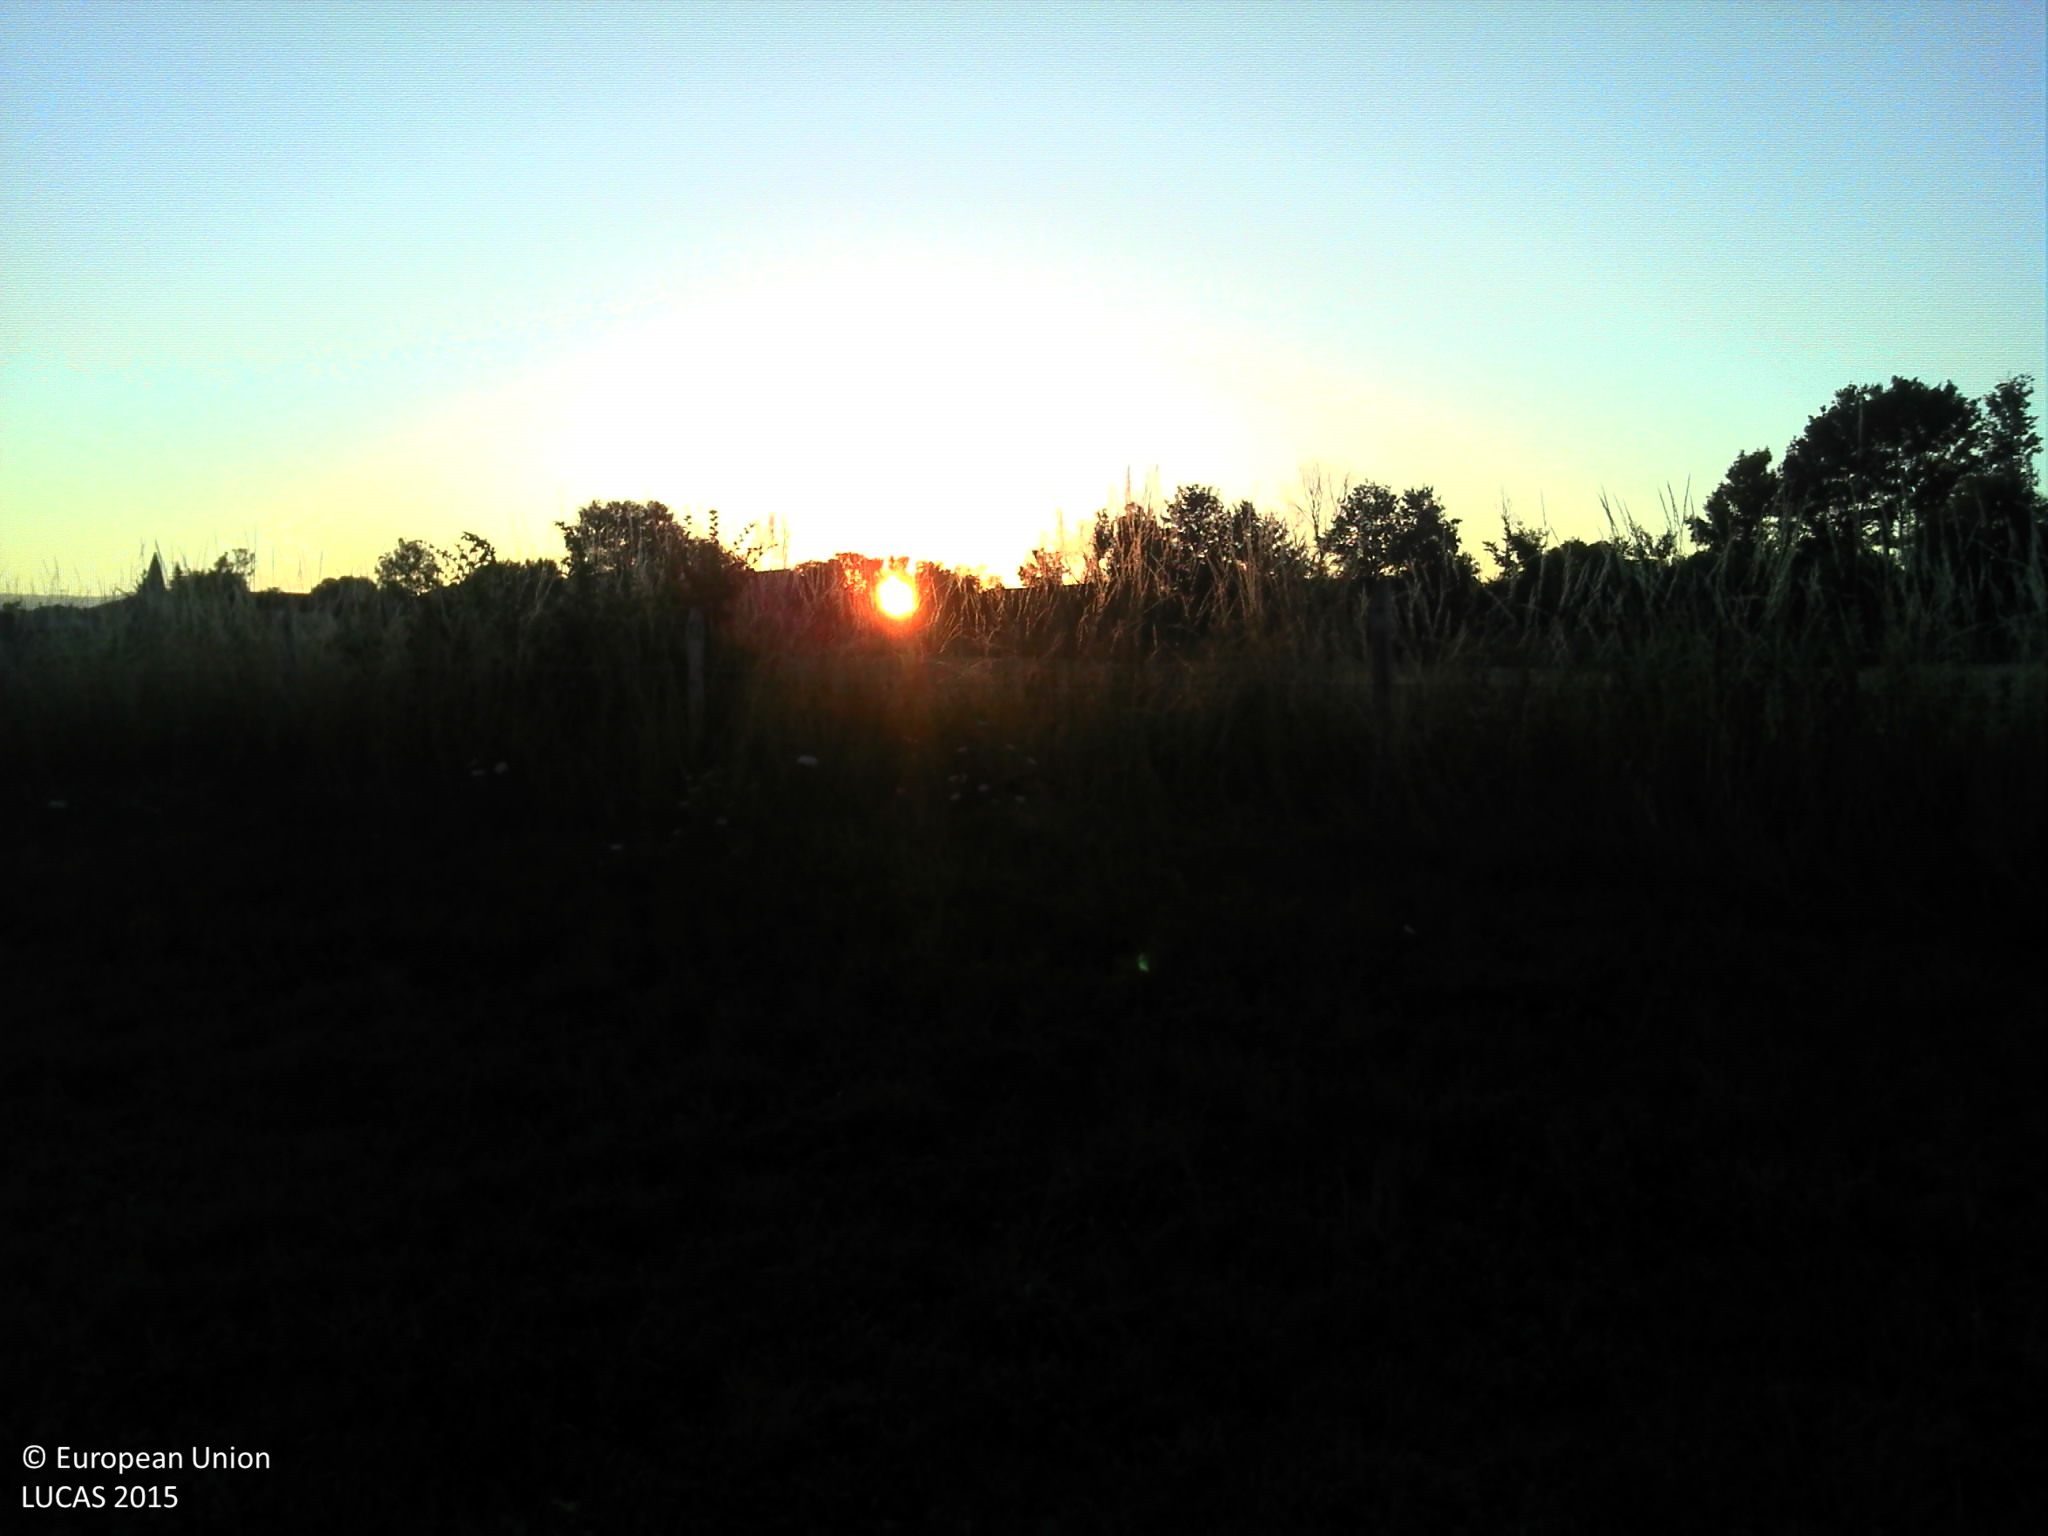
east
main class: Grassland
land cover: Grassland without tree/shrub cover
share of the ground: > 75 %
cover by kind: herbaceous plants 100 %
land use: Agriculture (excluding fallow land and kitchen gardens)
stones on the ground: < 10 %
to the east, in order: Grassland without tree/shrub cover; Fences; Abandoned hedges; Grassland without tree/shrub cover; Fences; Abandoned hedges; Grassland without tree/shrub cover; Fences; Abandoned hedges; Tracks; Fences; Abandoned hedges; Grassland without tree/shrub cover; Fences; Grassland without tree/shrub cover
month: July
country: FR
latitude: 45.1580
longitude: 3.4771
